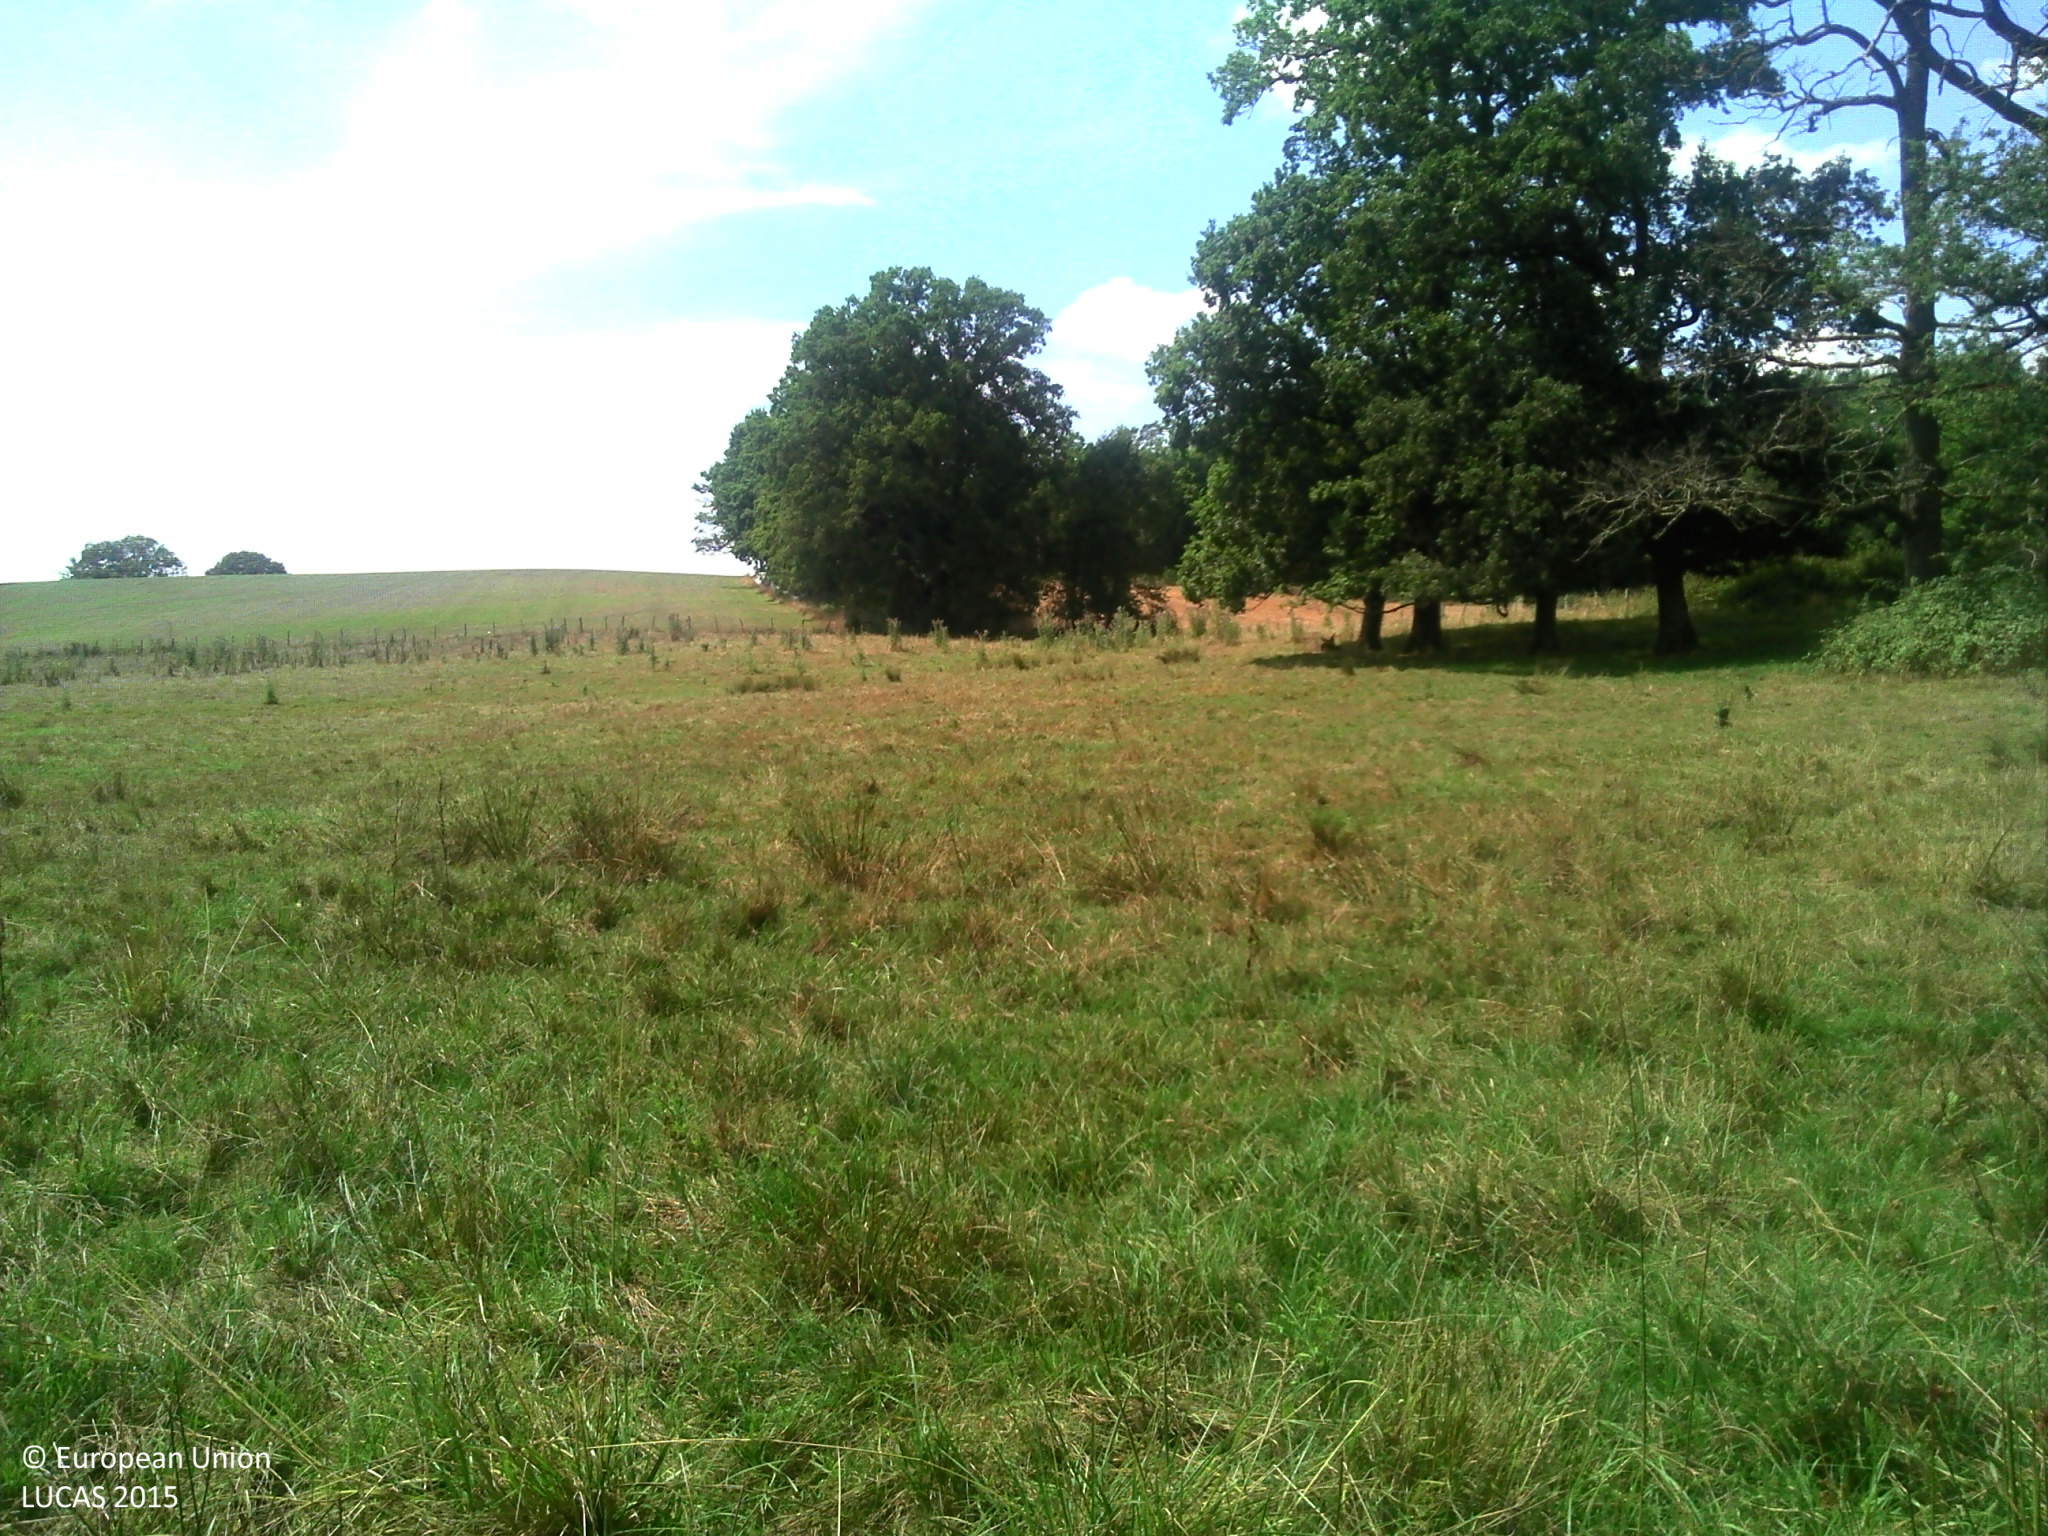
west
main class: Grassland
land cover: Grassland without tree/shrub cover
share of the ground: > 75 %
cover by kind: herbaceous plants 95 %
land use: Agriculture (excluding fallow land and kitchen gardens)
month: August
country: FR
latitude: 45.6882
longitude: 1.2986
